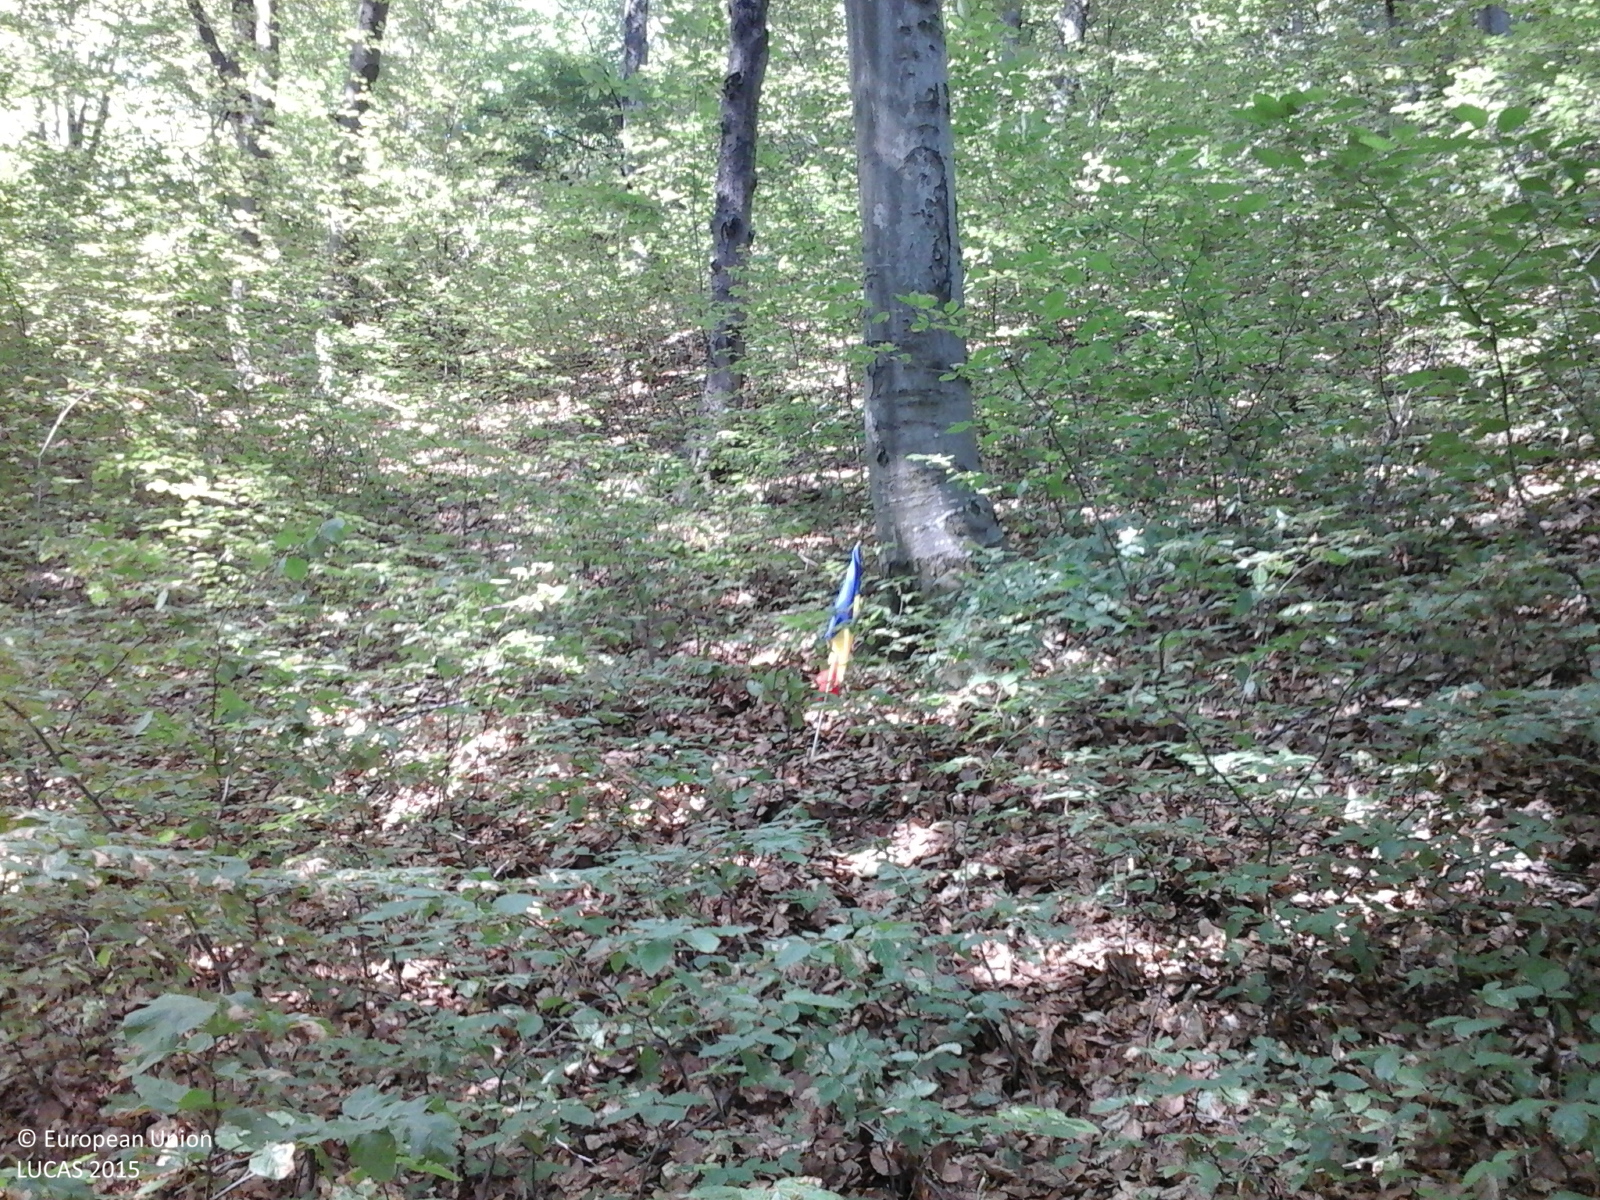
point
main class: Woodland
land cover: Broadleaved woodland
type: beech forest
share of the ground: > 75 %
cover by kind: broadleaved forest trees 100 %
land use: Forestry
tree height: > 5 m
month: June
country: RO
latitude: 46.5113
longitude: 26.8388
